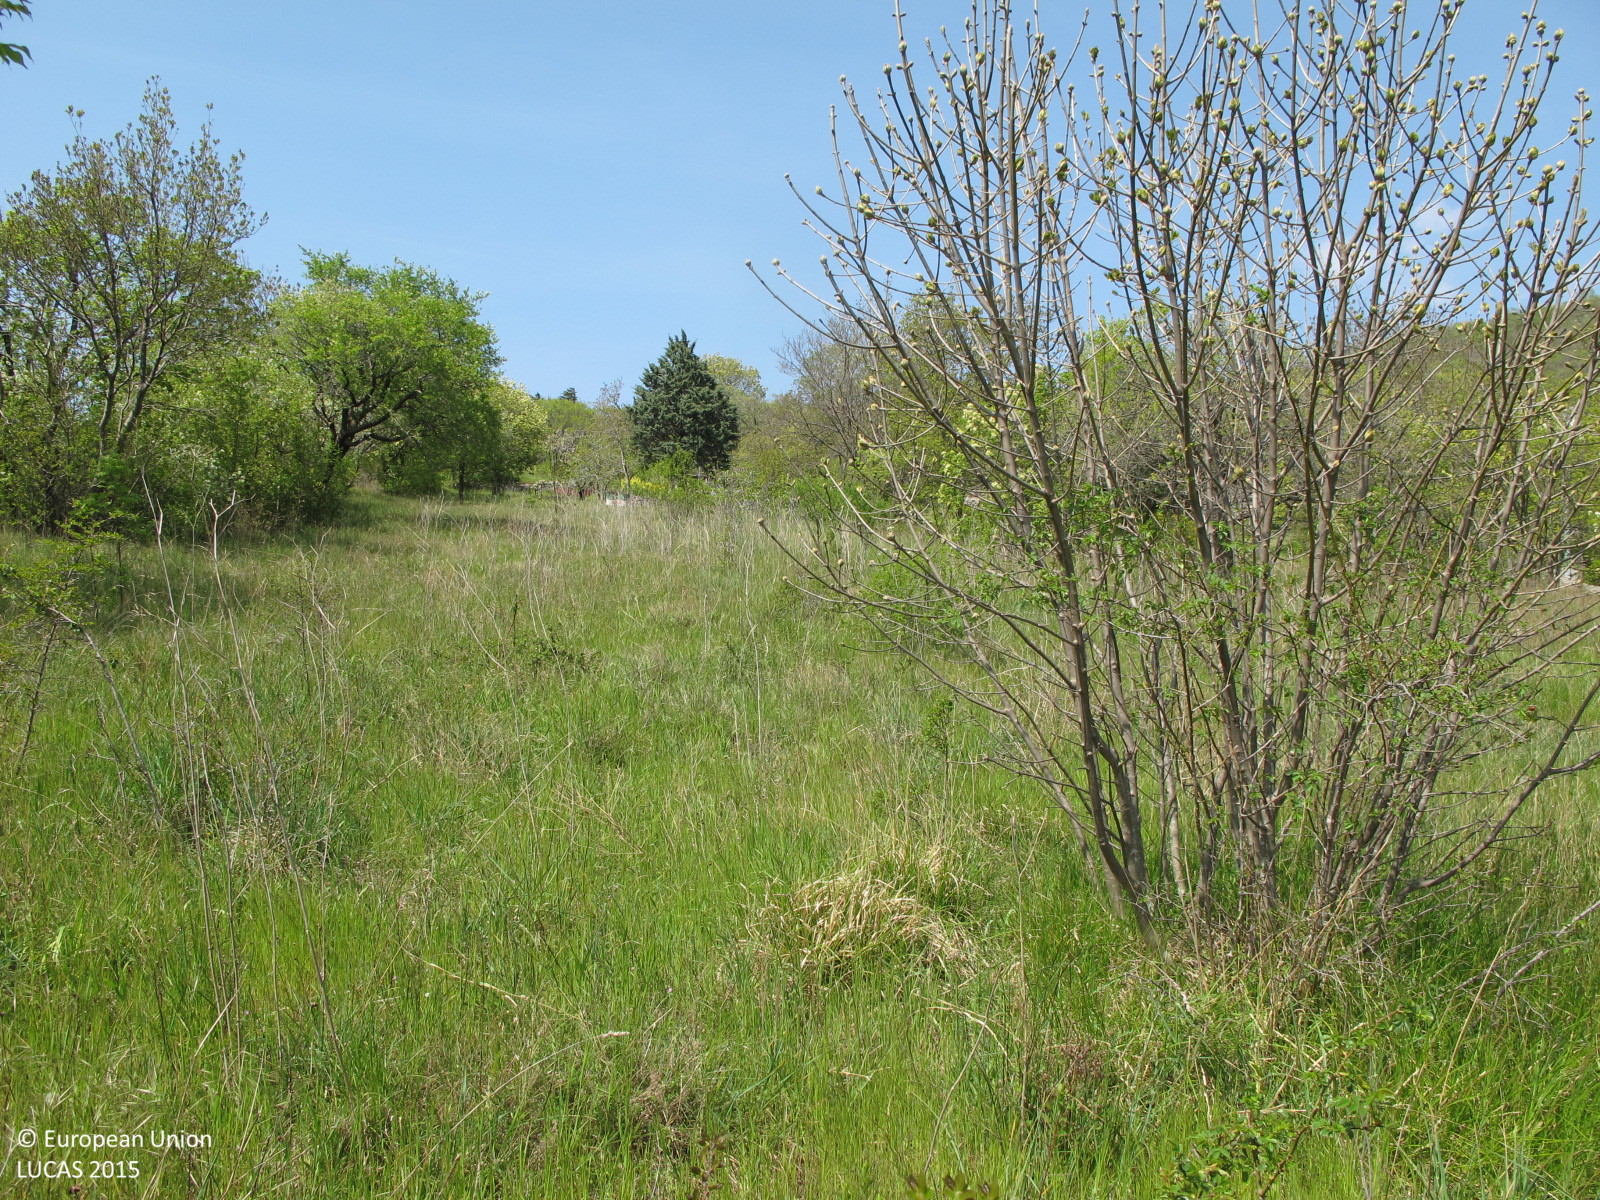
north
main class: Grassland
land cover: Grassland with sparse tree/shrub cover
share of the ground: > 75 %
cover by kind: herbaceous plants 70 %, shrubs 10 %, broadleaved forest trees 5 %
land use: Abandoned areas
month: April
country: HR
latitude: 45.2971
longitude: 14.5729
